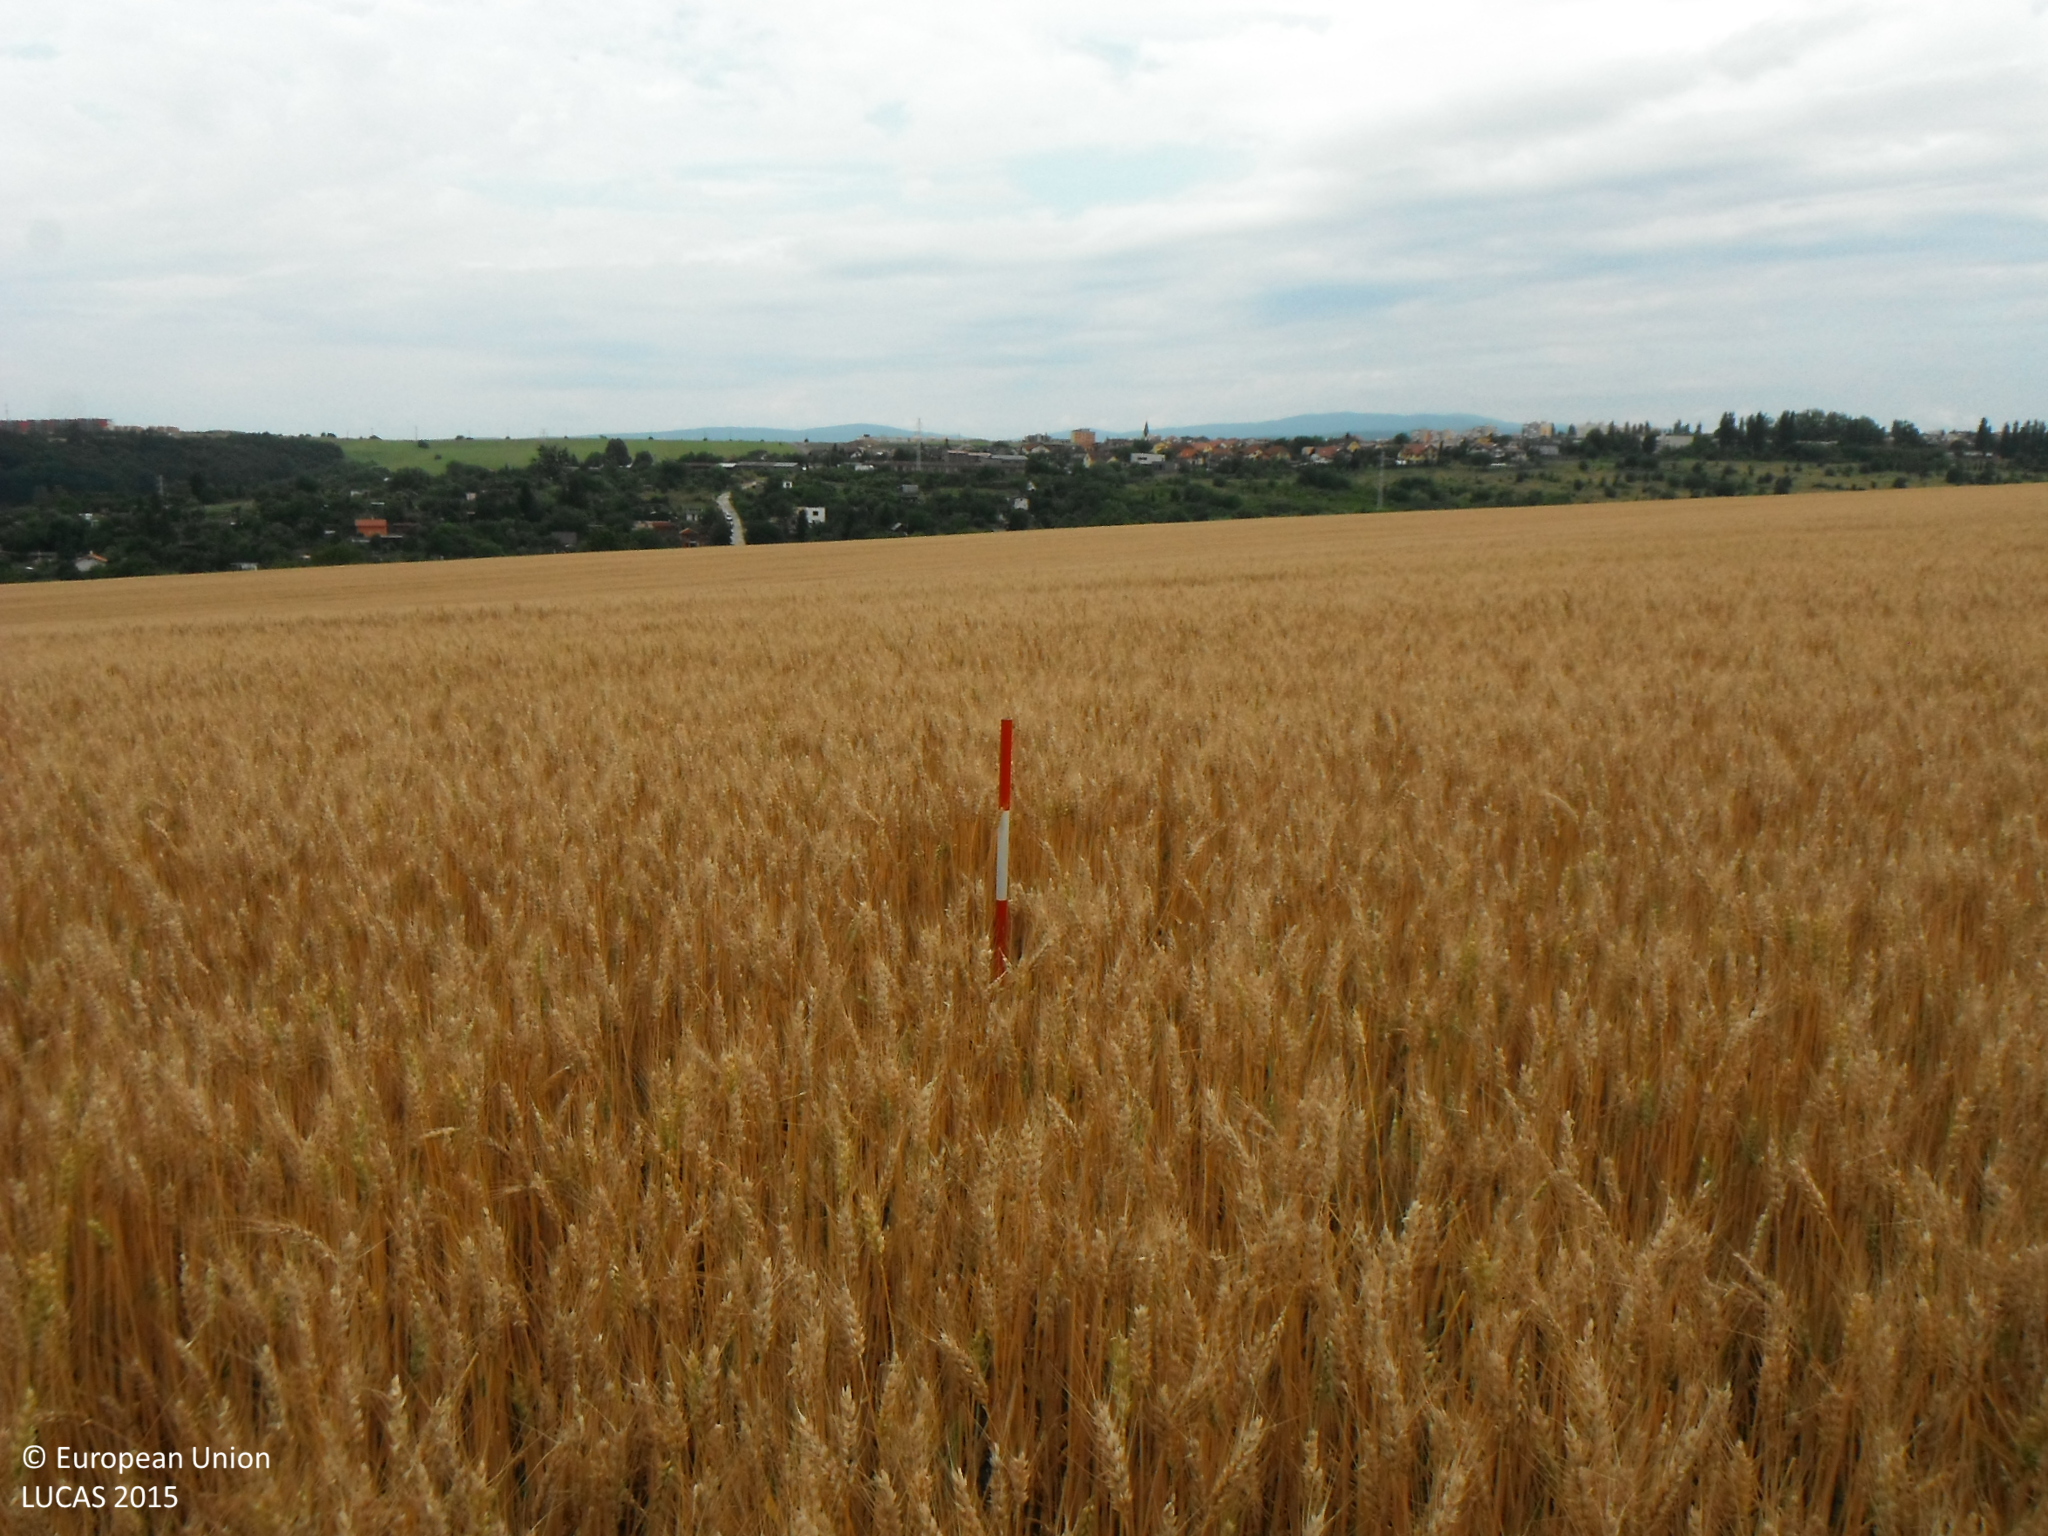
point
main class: Cropland
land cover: Common wheat
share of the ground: > 75 %
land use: Agriculture (excluding fallow land and kitchen gardens)
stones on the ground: 10 - 25 %
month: July
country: SK
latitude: 48.7289
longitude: 21.3156
